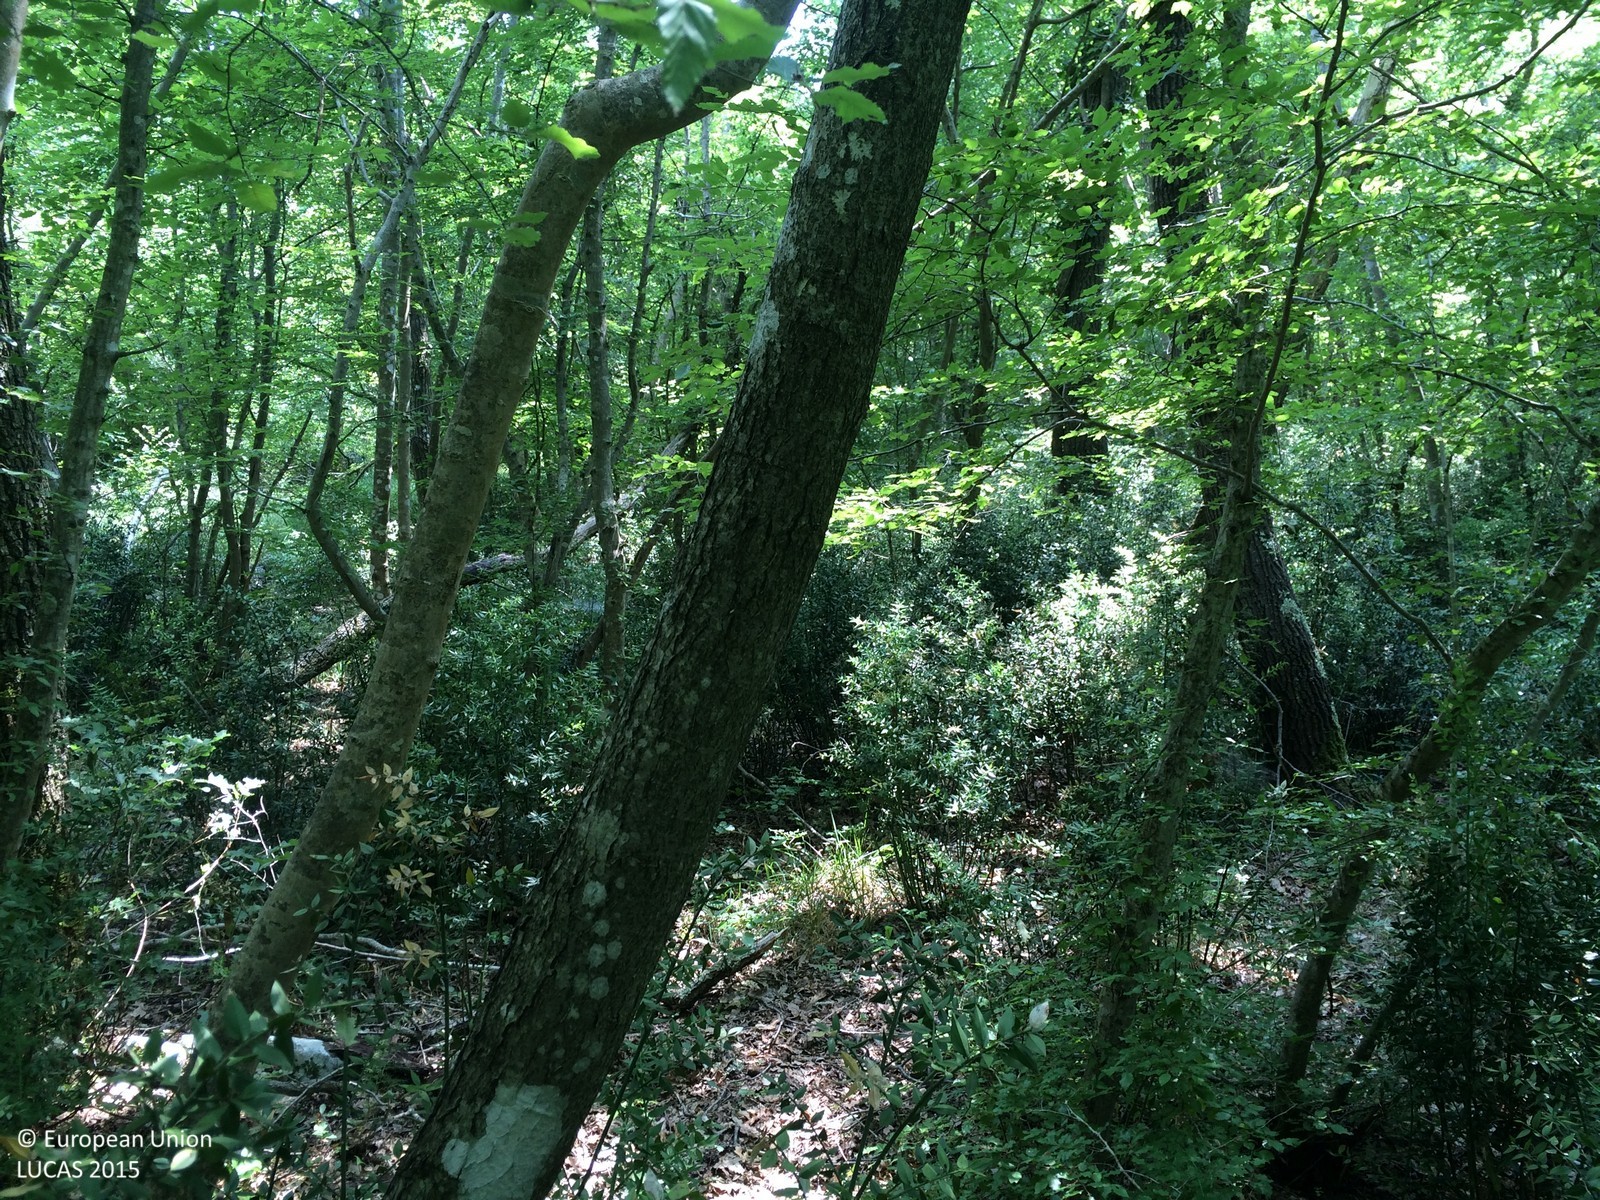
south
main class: Woodland
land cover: Broadleaved woodland
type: beech forest
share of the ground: > 75 %
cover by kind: broadleaved forest trees 90 %, shrubs 10 %
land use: Semi-natural and natural areas not in use
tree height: > 5 m
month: June
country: HR
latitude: 45.1114
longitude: 13.7950
